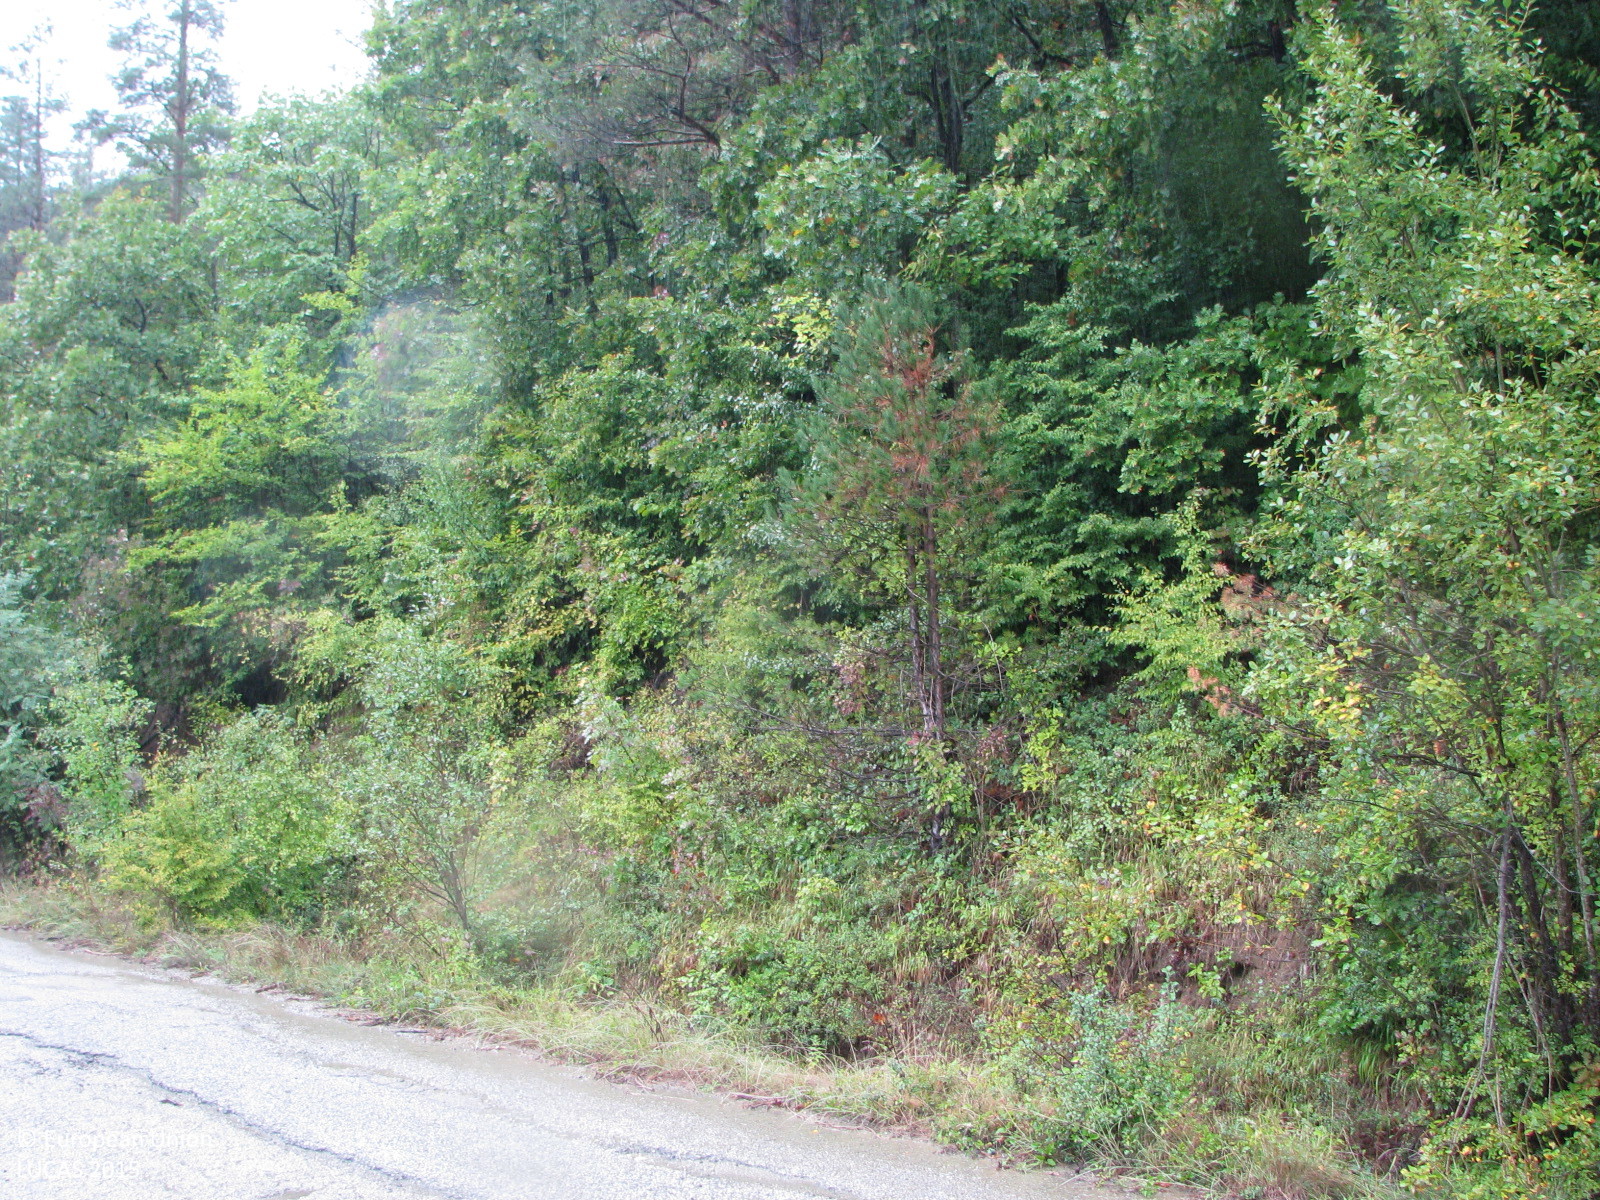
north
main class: Woodland
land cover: Broadleaved woodland
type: mesophytic deciduous forest
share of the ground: > 75 %
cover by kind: broadleaved forest trees 100 %
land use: Forestry
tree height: > 5 m
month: September
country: BG
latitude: 42.9633
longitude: 26.3883
